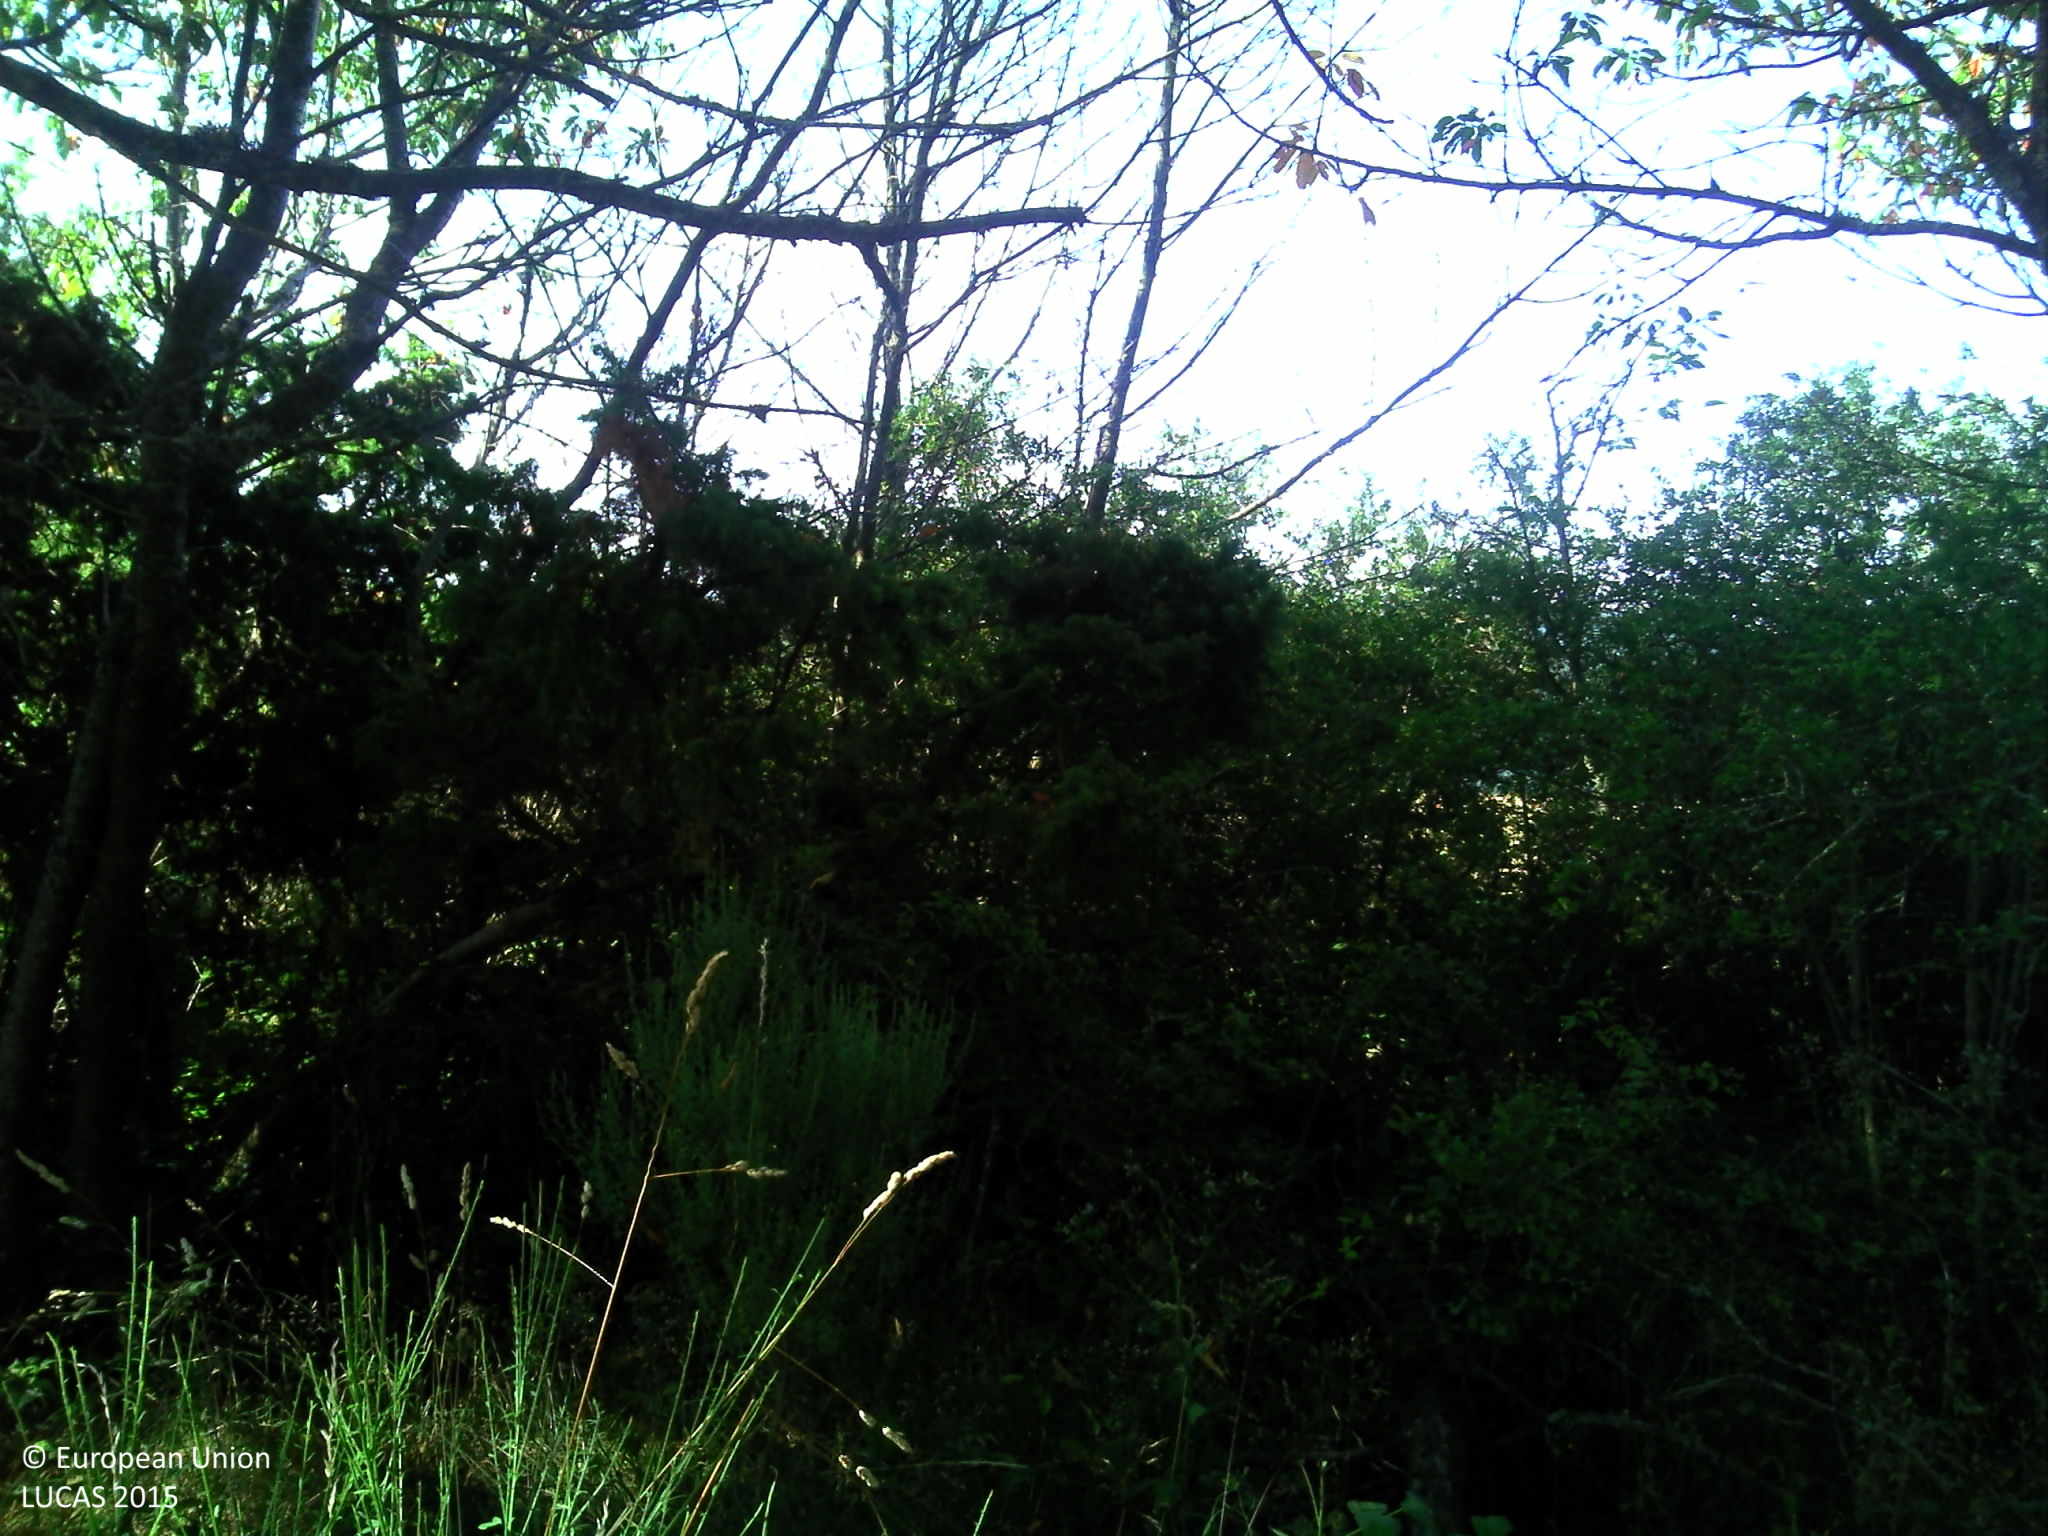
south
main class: Woodland
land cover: Pine dominated mixed woodland
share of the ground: > 75 %
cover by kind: coniferous forest trees 75 %, broadleaved forest trees 25 %
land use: Semi-natural and natural areas not in use
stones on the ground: < 10 %
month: July
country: FR
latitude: 45.0276
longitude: 3.4160
